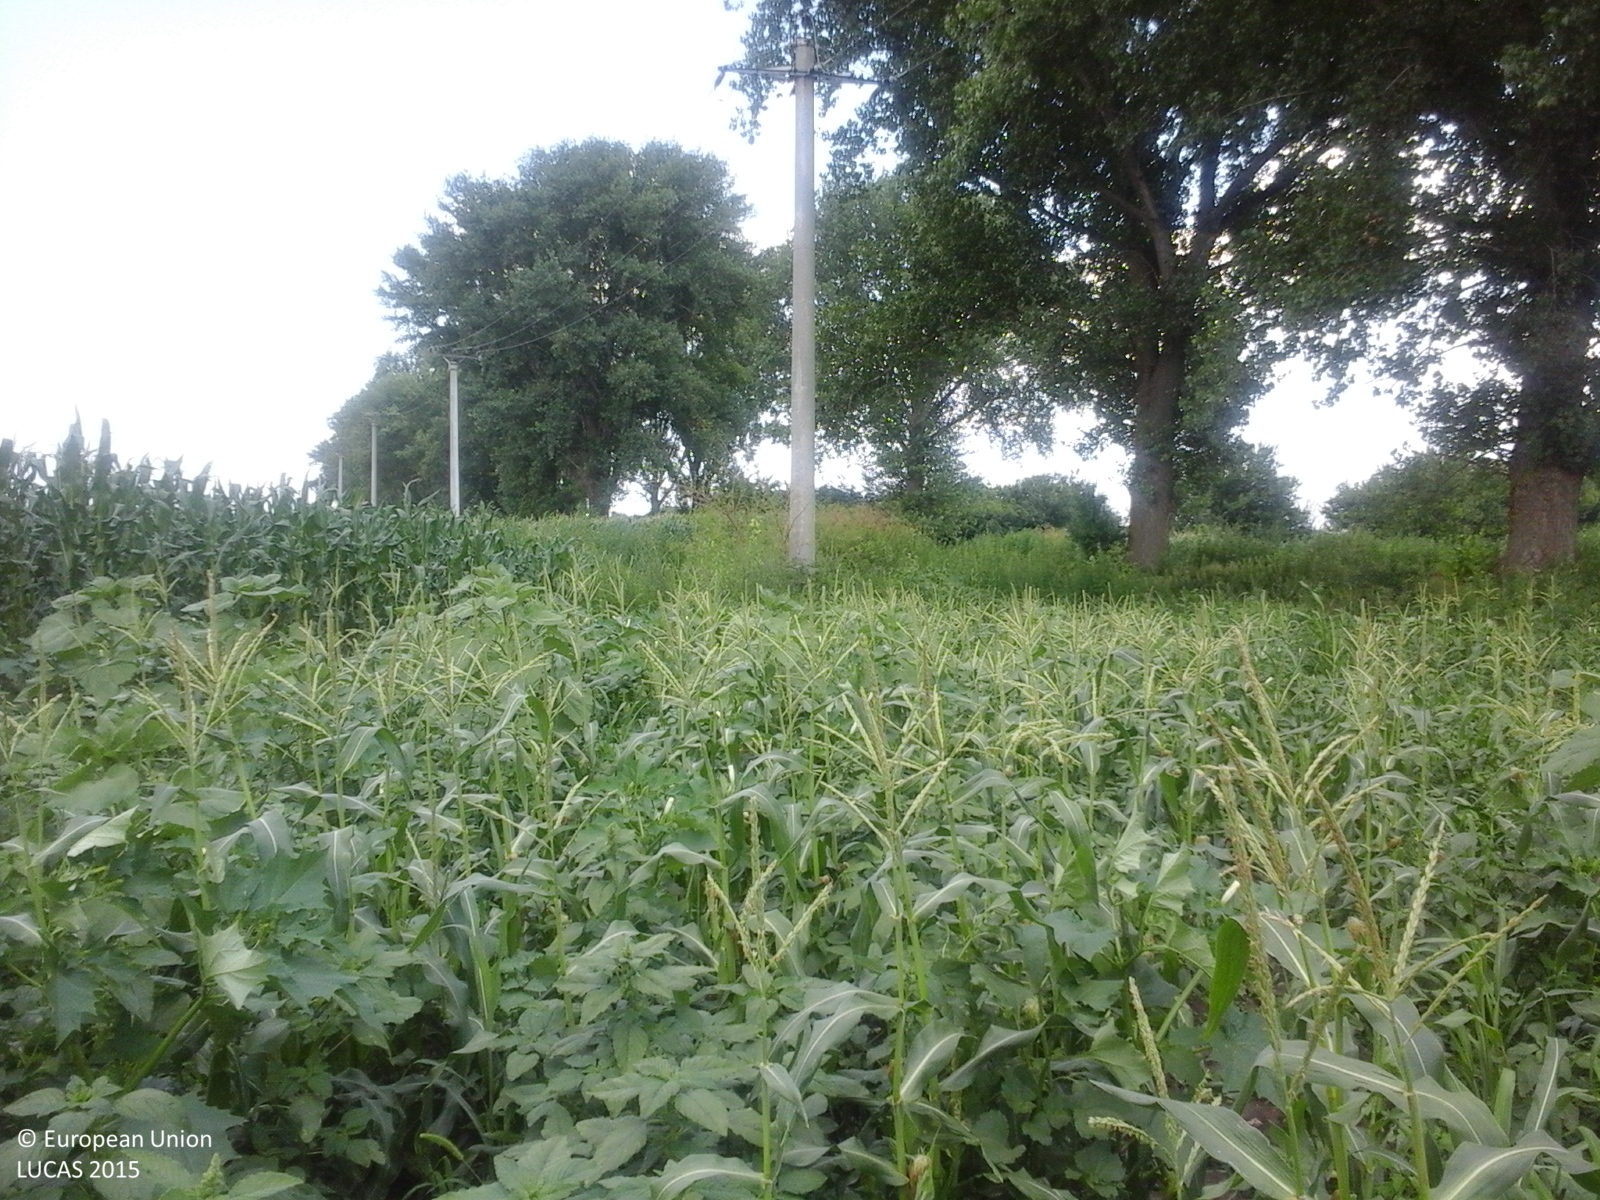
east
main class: Cropland
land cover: Maize
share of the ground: 50 - 75 %
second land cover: Other fresh vegetables
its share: 25 - 50 %
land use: Agriculture (excluding fallow land and kitchen gardens)
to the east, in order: Maize; Other fresh vegetables; Electric lines; Maize; Lines of trees; Paved roads, cycling and walking lanes; Grass margins; Maize; Common wheat; Cherry fruit; Common wheat; Maize; Common wheat
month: July
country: RO
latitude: 43.7345
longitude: 25.6948
